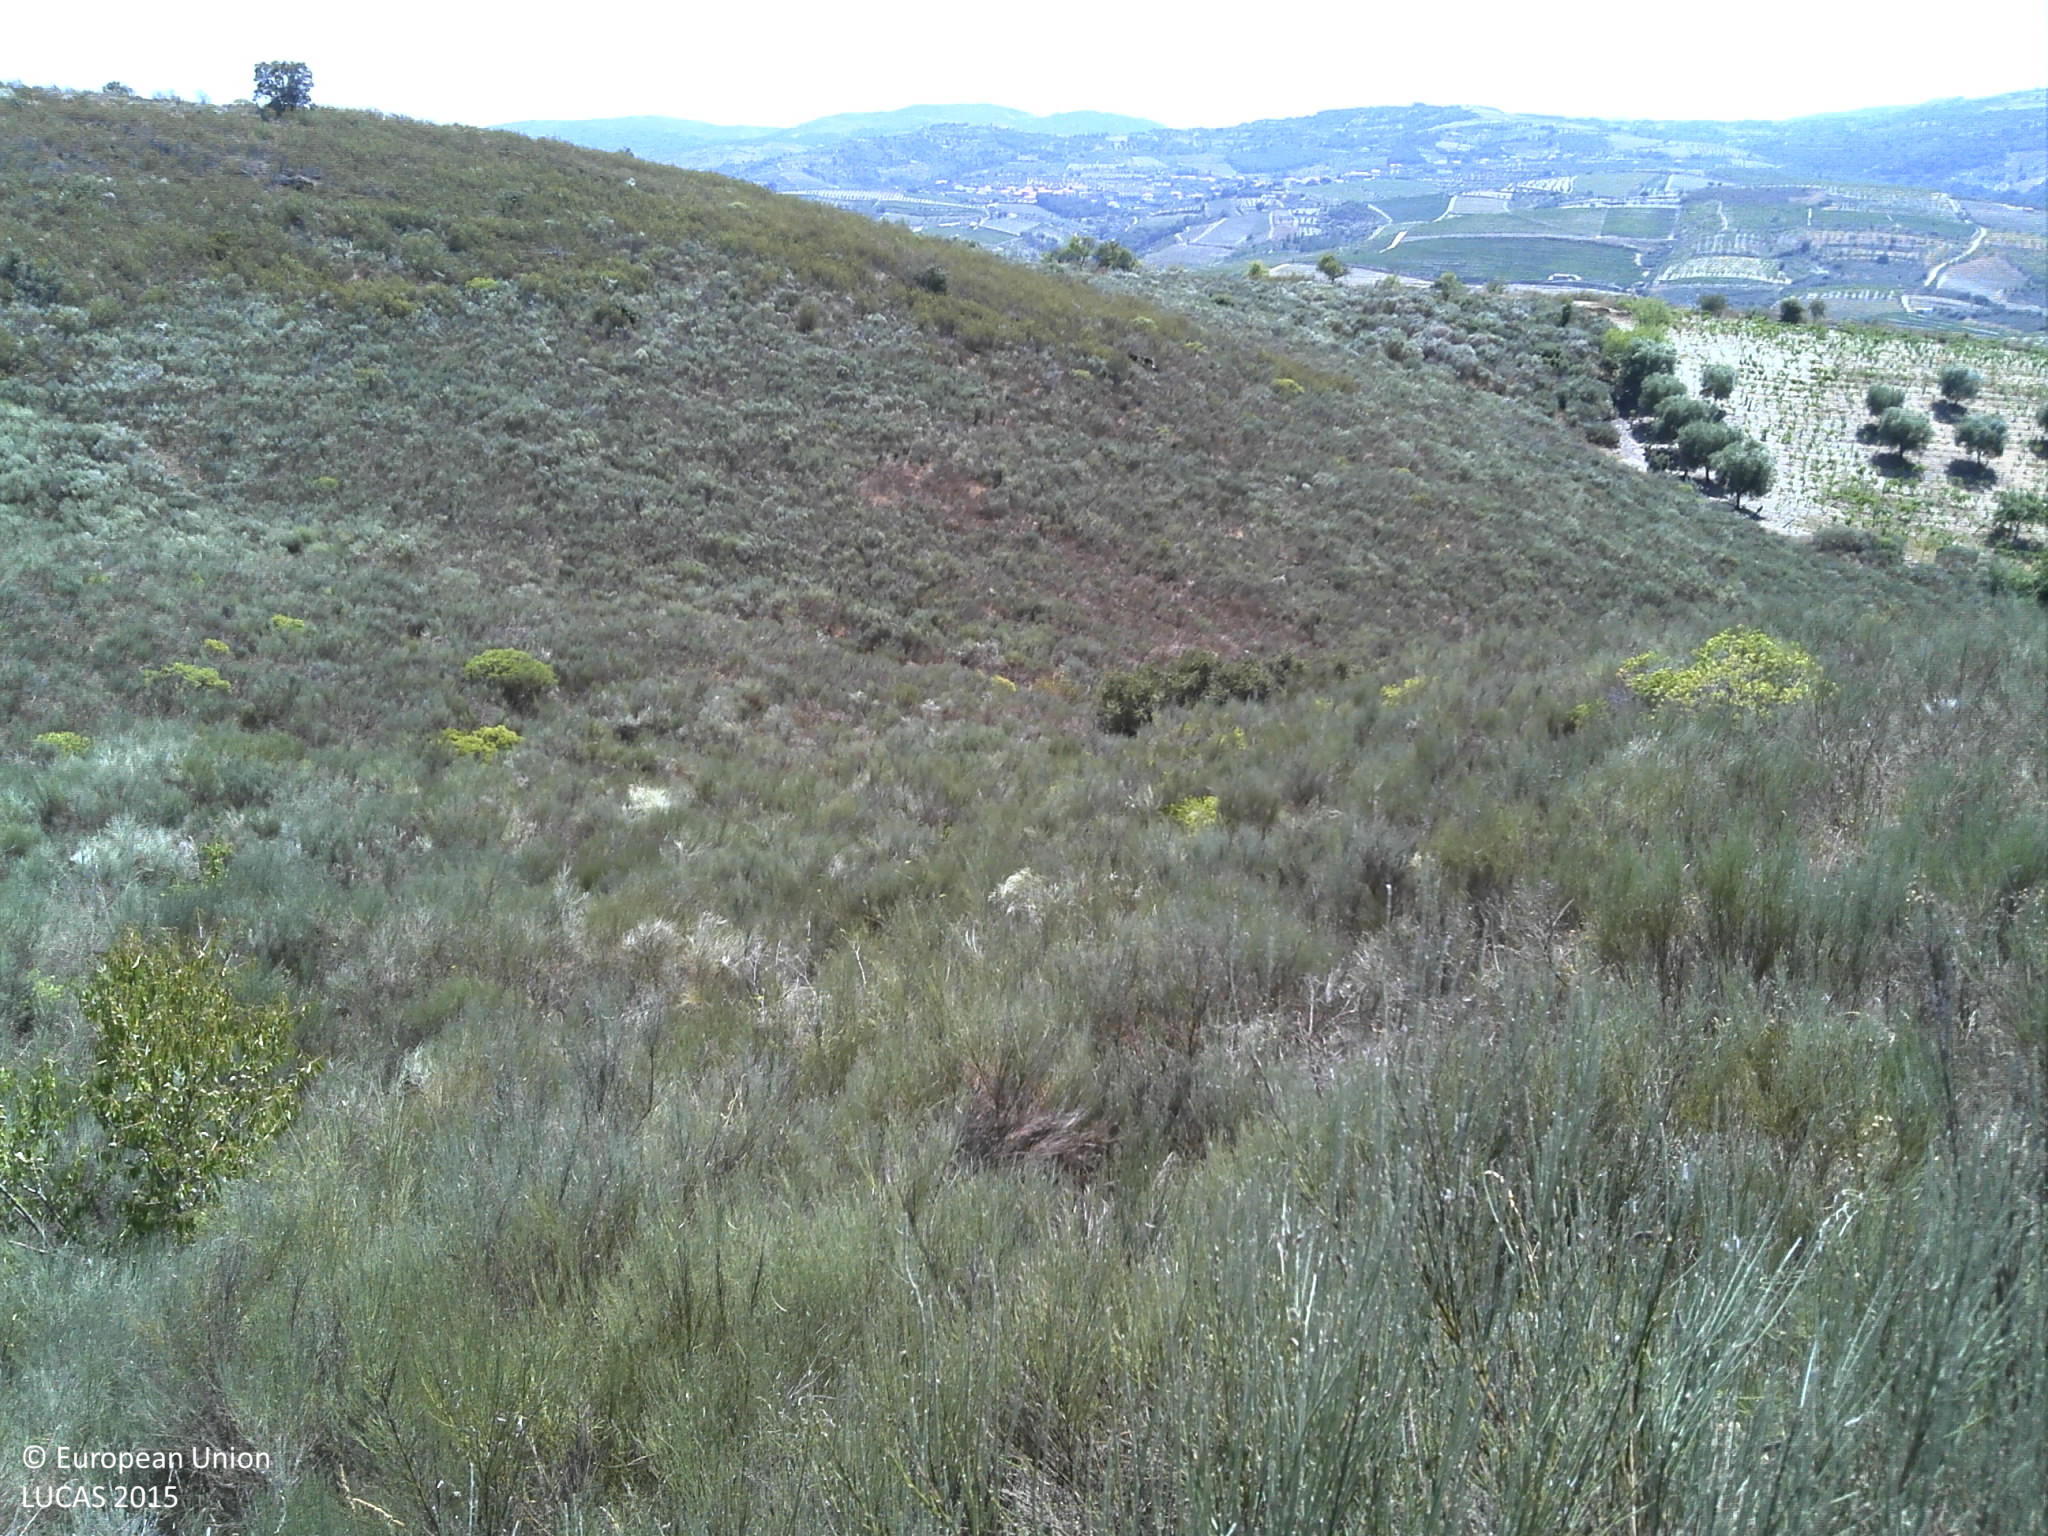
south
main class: Shrubland
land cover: Shrubland without tree cover
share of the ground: > 75 %
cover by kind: shrubs 100 %
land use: Semi-natural and natural areas not in use
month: July
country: PT
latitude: 41.0984
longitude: -7.3941
